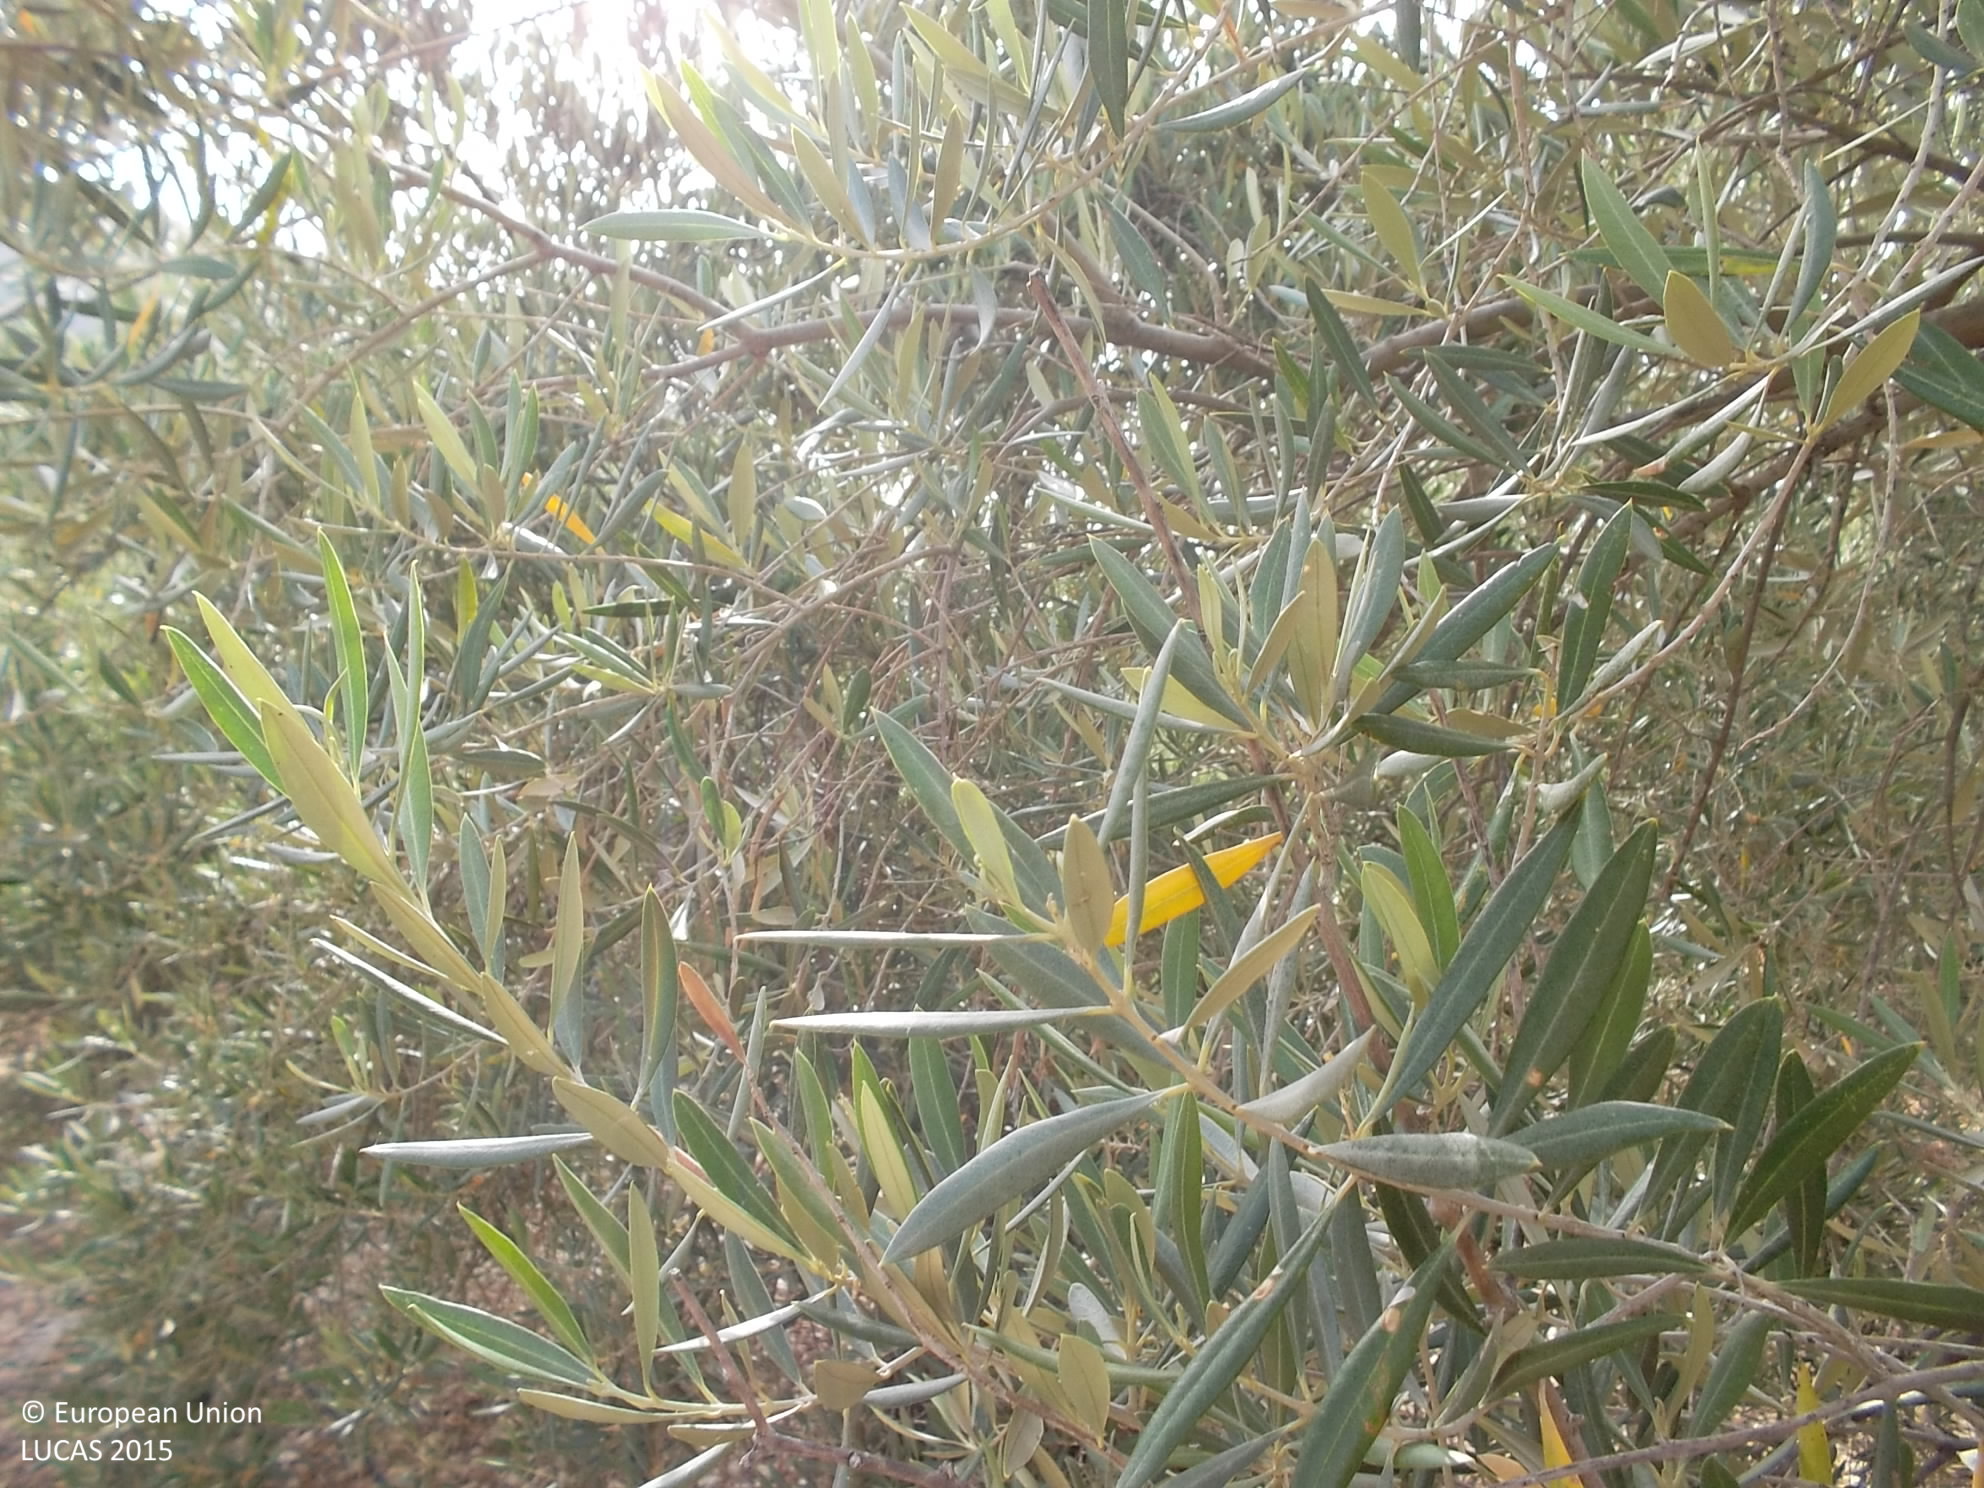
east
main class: Cropland
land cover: Olive groves
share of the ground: 50 - 75 %
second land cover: Other bare soil
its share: > 75 %
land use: Agriculture (excluding fallow land and kitchen gardens)
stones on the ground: 10 - 25 %
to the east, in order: Olive groves; Other bare soil; Grass margins; Olive groves; Grass margins; Olive groves; Grass margins; Olive groves; Electric lines; Grass margins; Olive groves; Groves; Olive groves; Nuts trees; Olive groves; Ditches and canals; Shrubland without tree cover; Olive groves; Grass margins; Olive groves
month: July
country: ES
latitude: 37.5522
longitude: -2.8360
